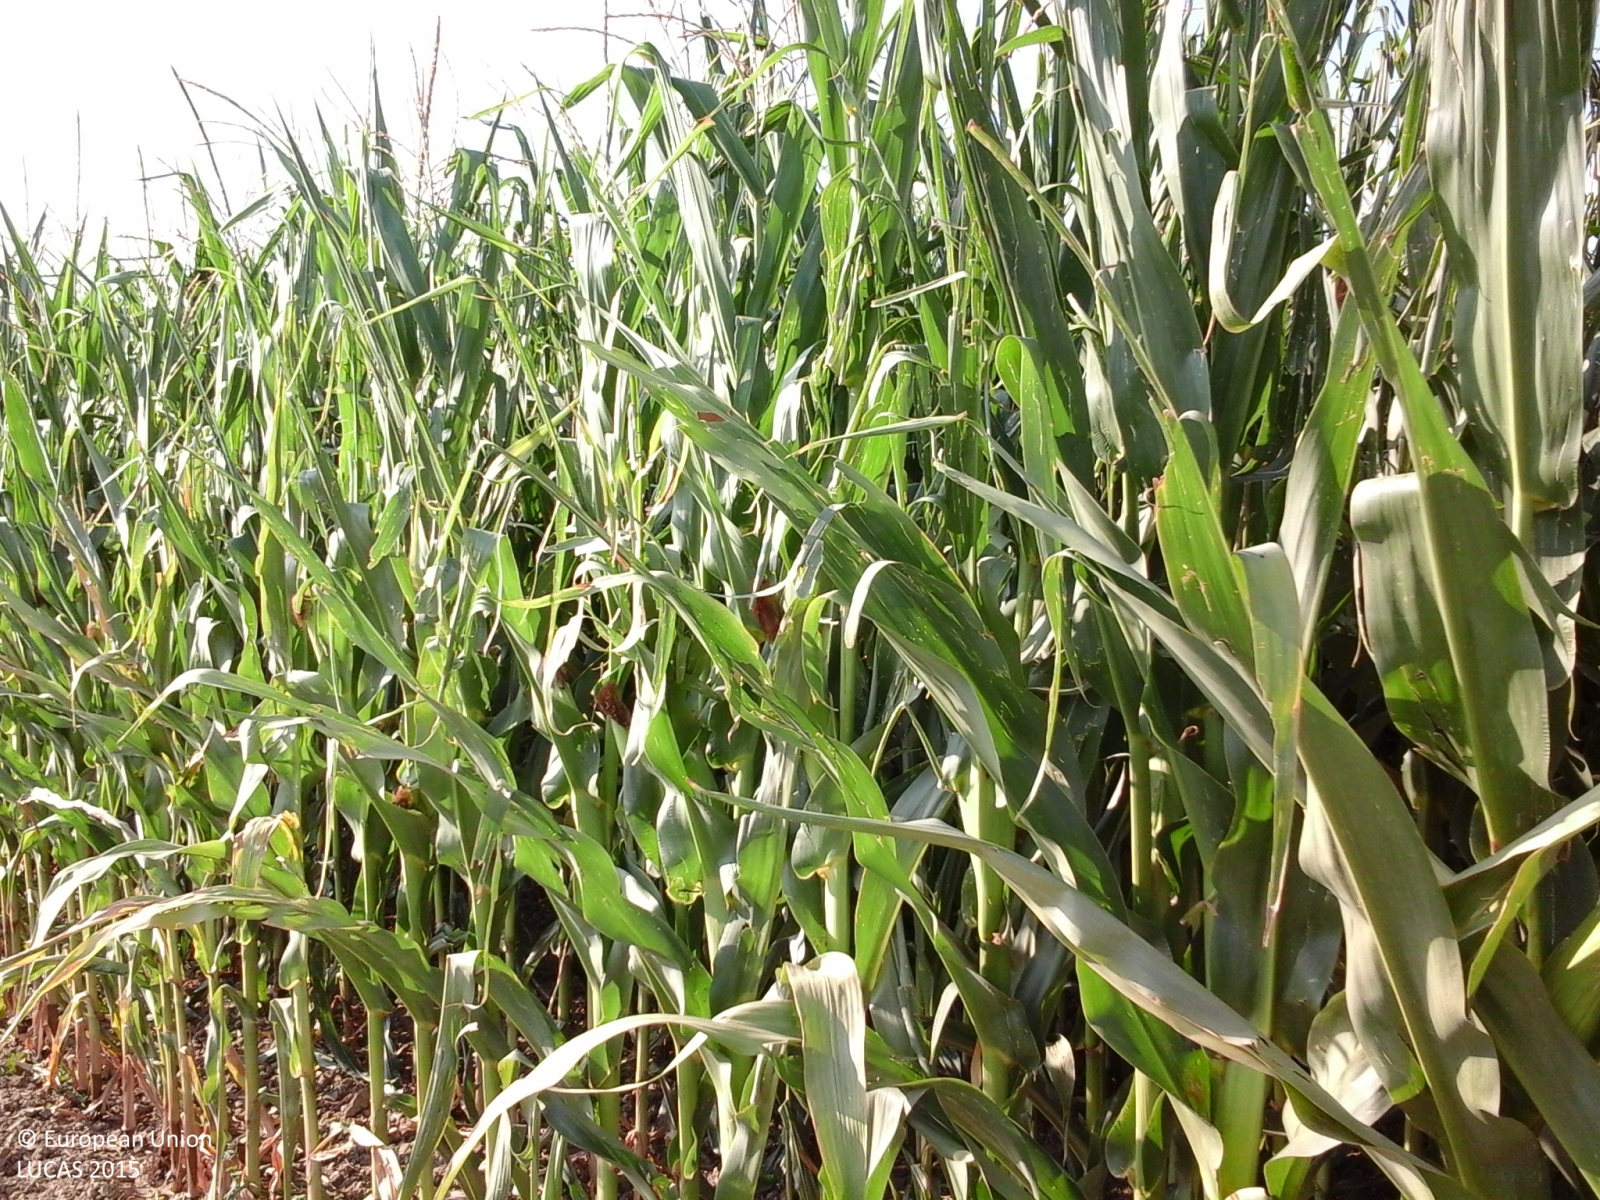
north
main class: Cropland
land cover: Maize
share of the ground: > 75 %
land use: Agriculture (excluding fallow land and kitchen gardens)
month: July
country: IT
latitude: 44.7001
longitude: 11.5239
